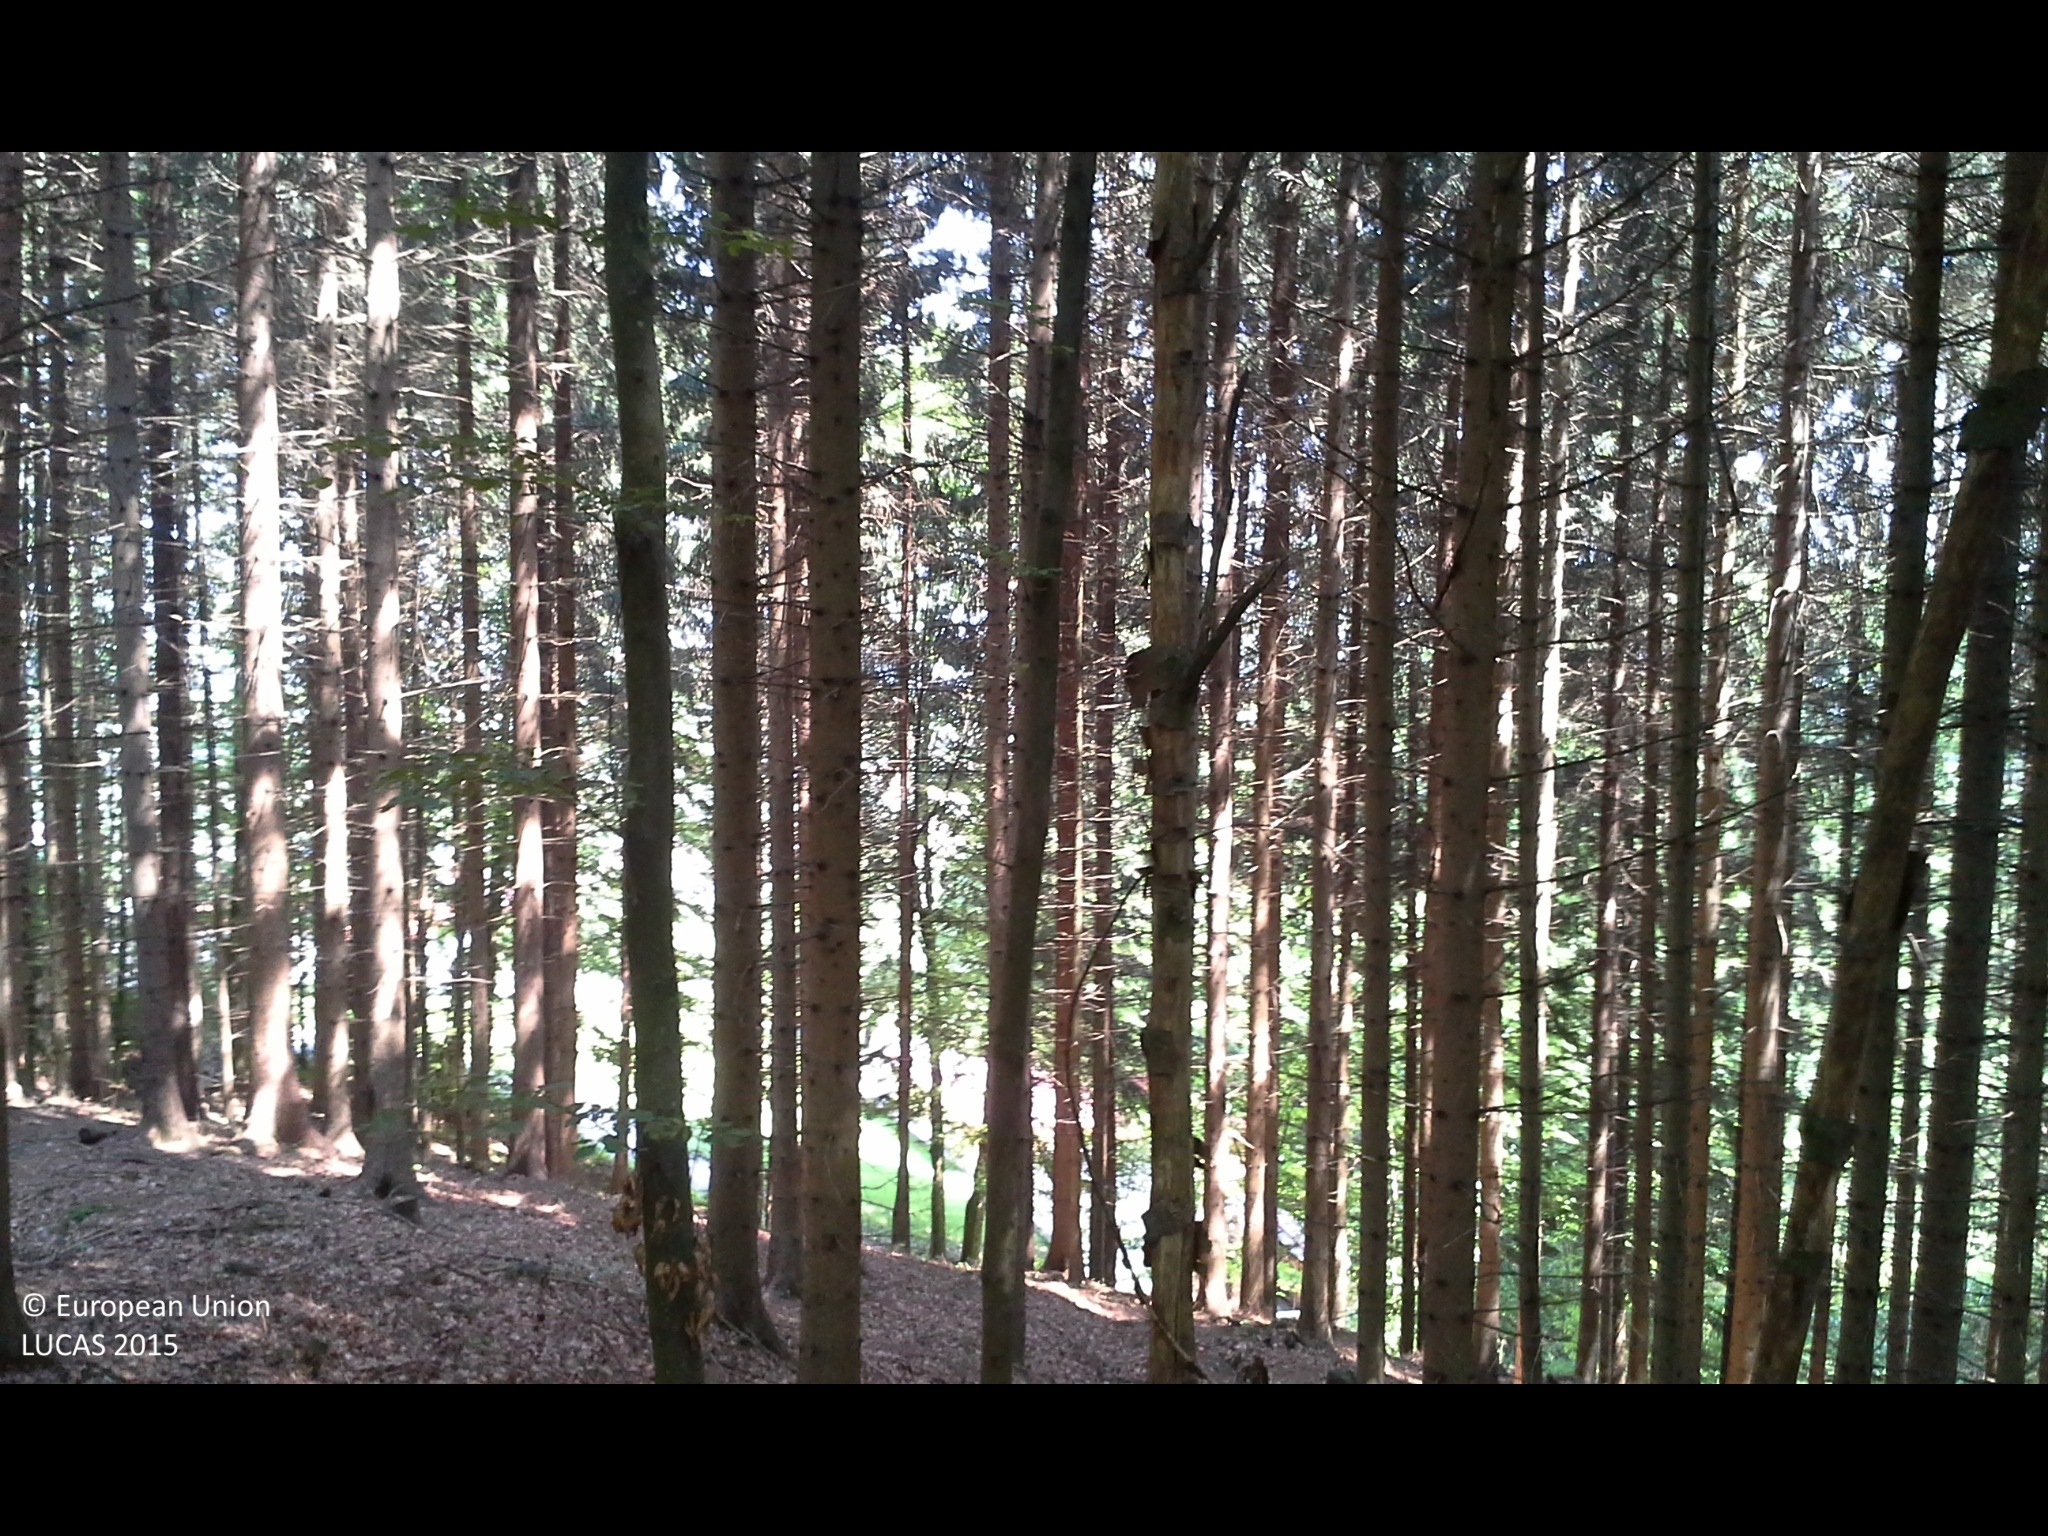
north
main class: Woodland
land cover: Spruce dominated mixed woodland
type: mountainous beech forest
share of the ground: > 75 %
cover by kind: coniferous forest trees 50 %, broadleaved forest trees 50 %
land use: Forestry
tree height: > 5 m
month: May
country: AT
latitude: 47.9647
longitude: 14.1649
